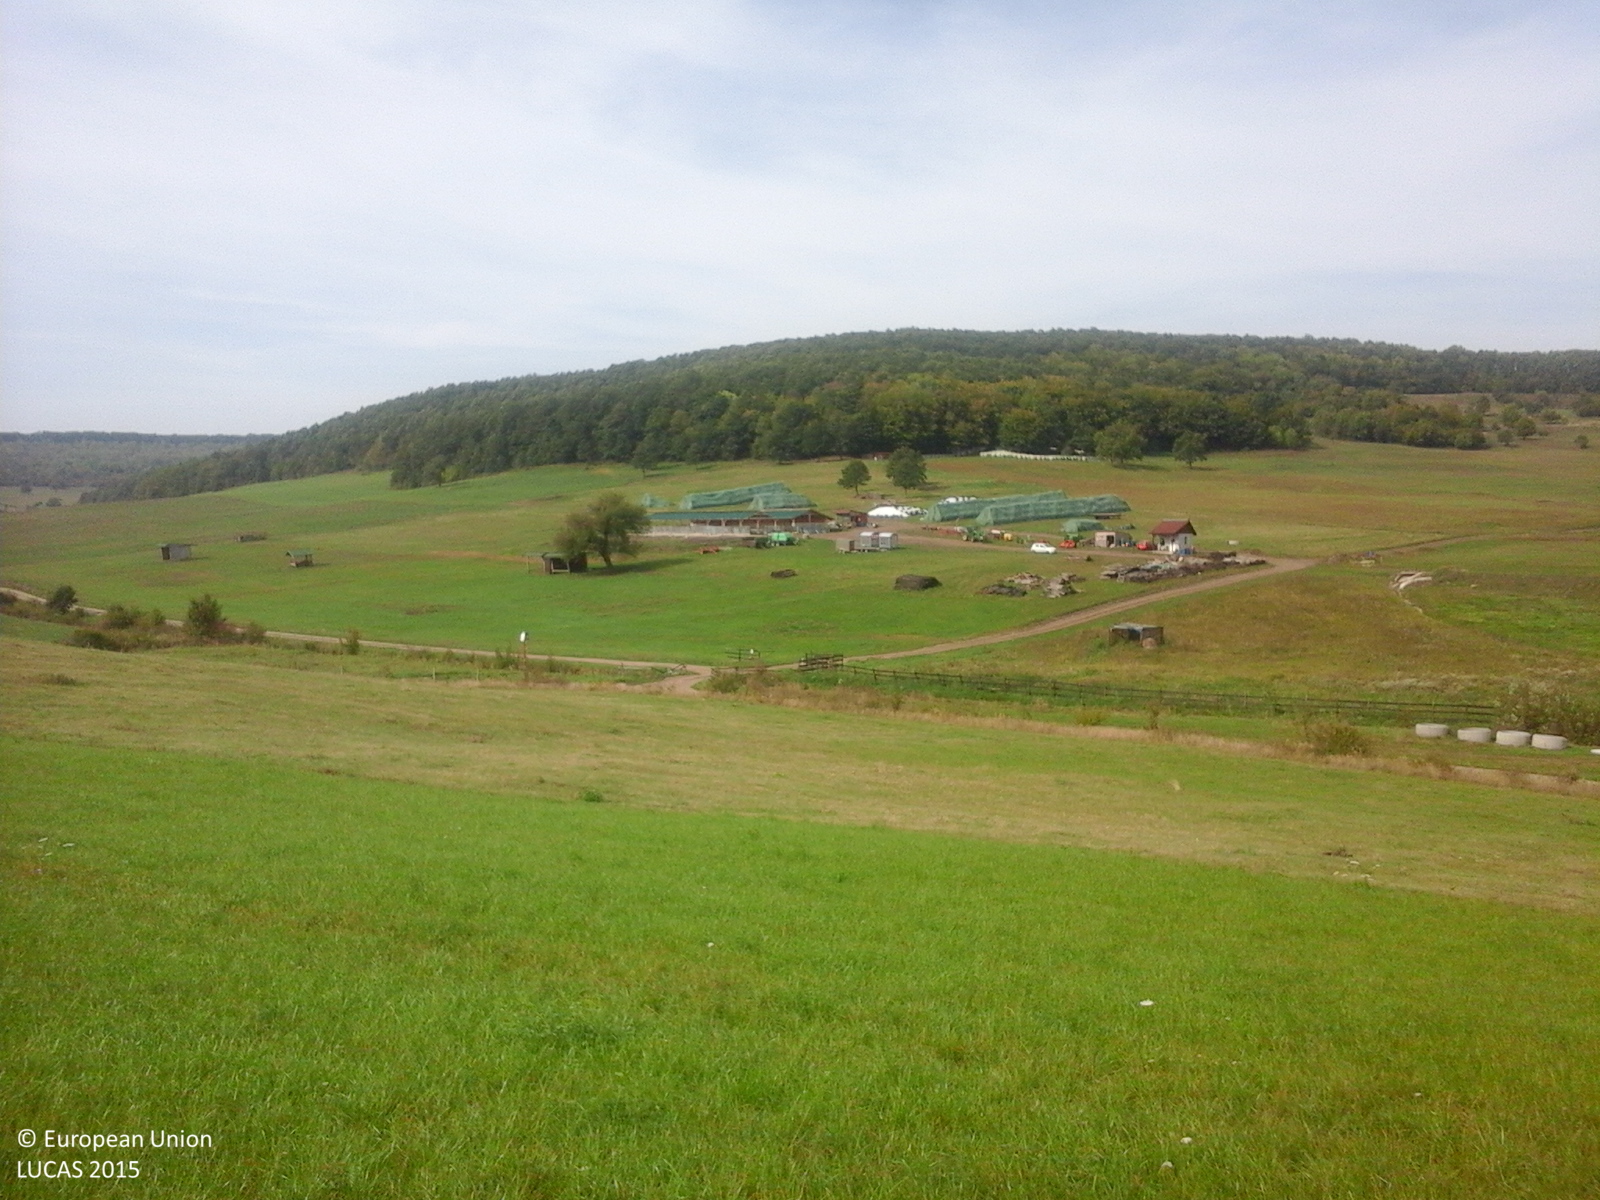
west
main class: Grassland
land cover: Grassland without tree/shrub cover
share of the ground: > 75 %
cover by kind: herbaceous plants 100 %
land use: Agriculture (excluding fallow land and kitchen gardens)
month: September
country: RO
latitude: 46.9589
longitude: 23.4339
